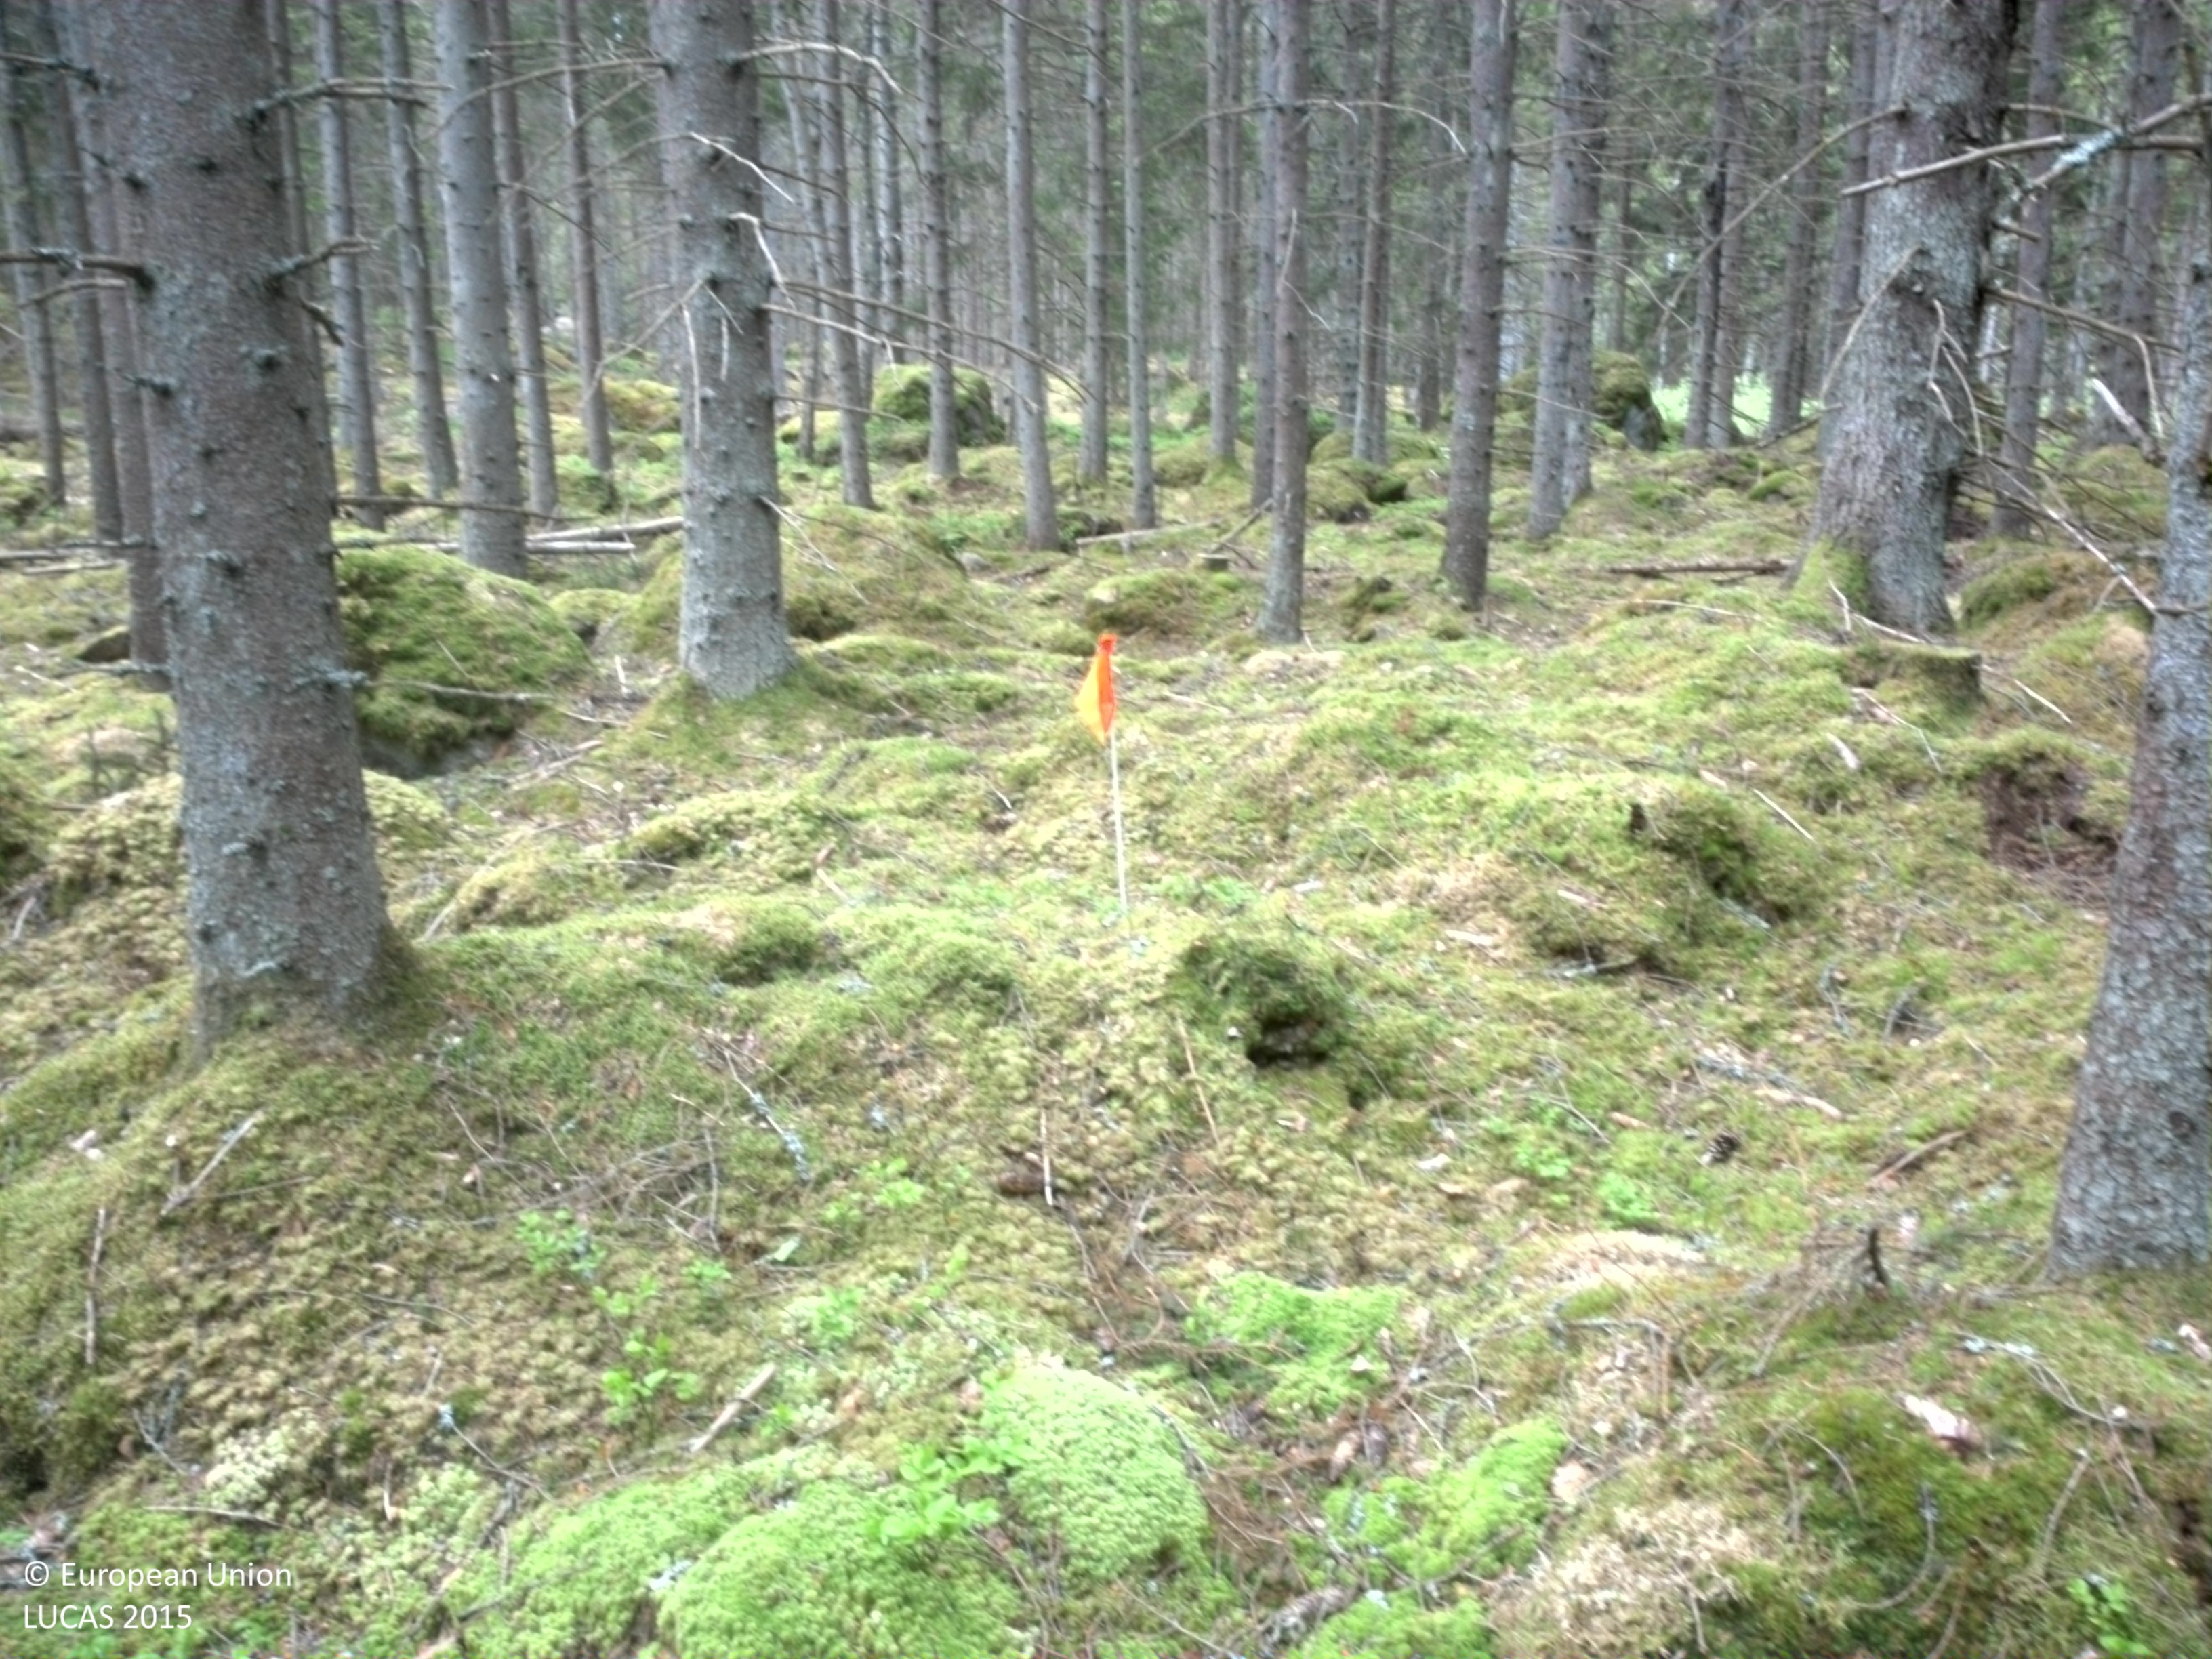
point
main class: Woodland
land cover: Spruce dominated coniferous woodland
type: boreal forest
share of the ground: > 75 %
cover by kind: coniferous forest trees 85 %, lichens and mosses 10 %, broadleaved forest trees 5 %
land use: Forestry
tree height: > 5 m
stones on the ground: < 10 %
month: May
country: SE
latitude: 56.5540
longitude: 15.1228
